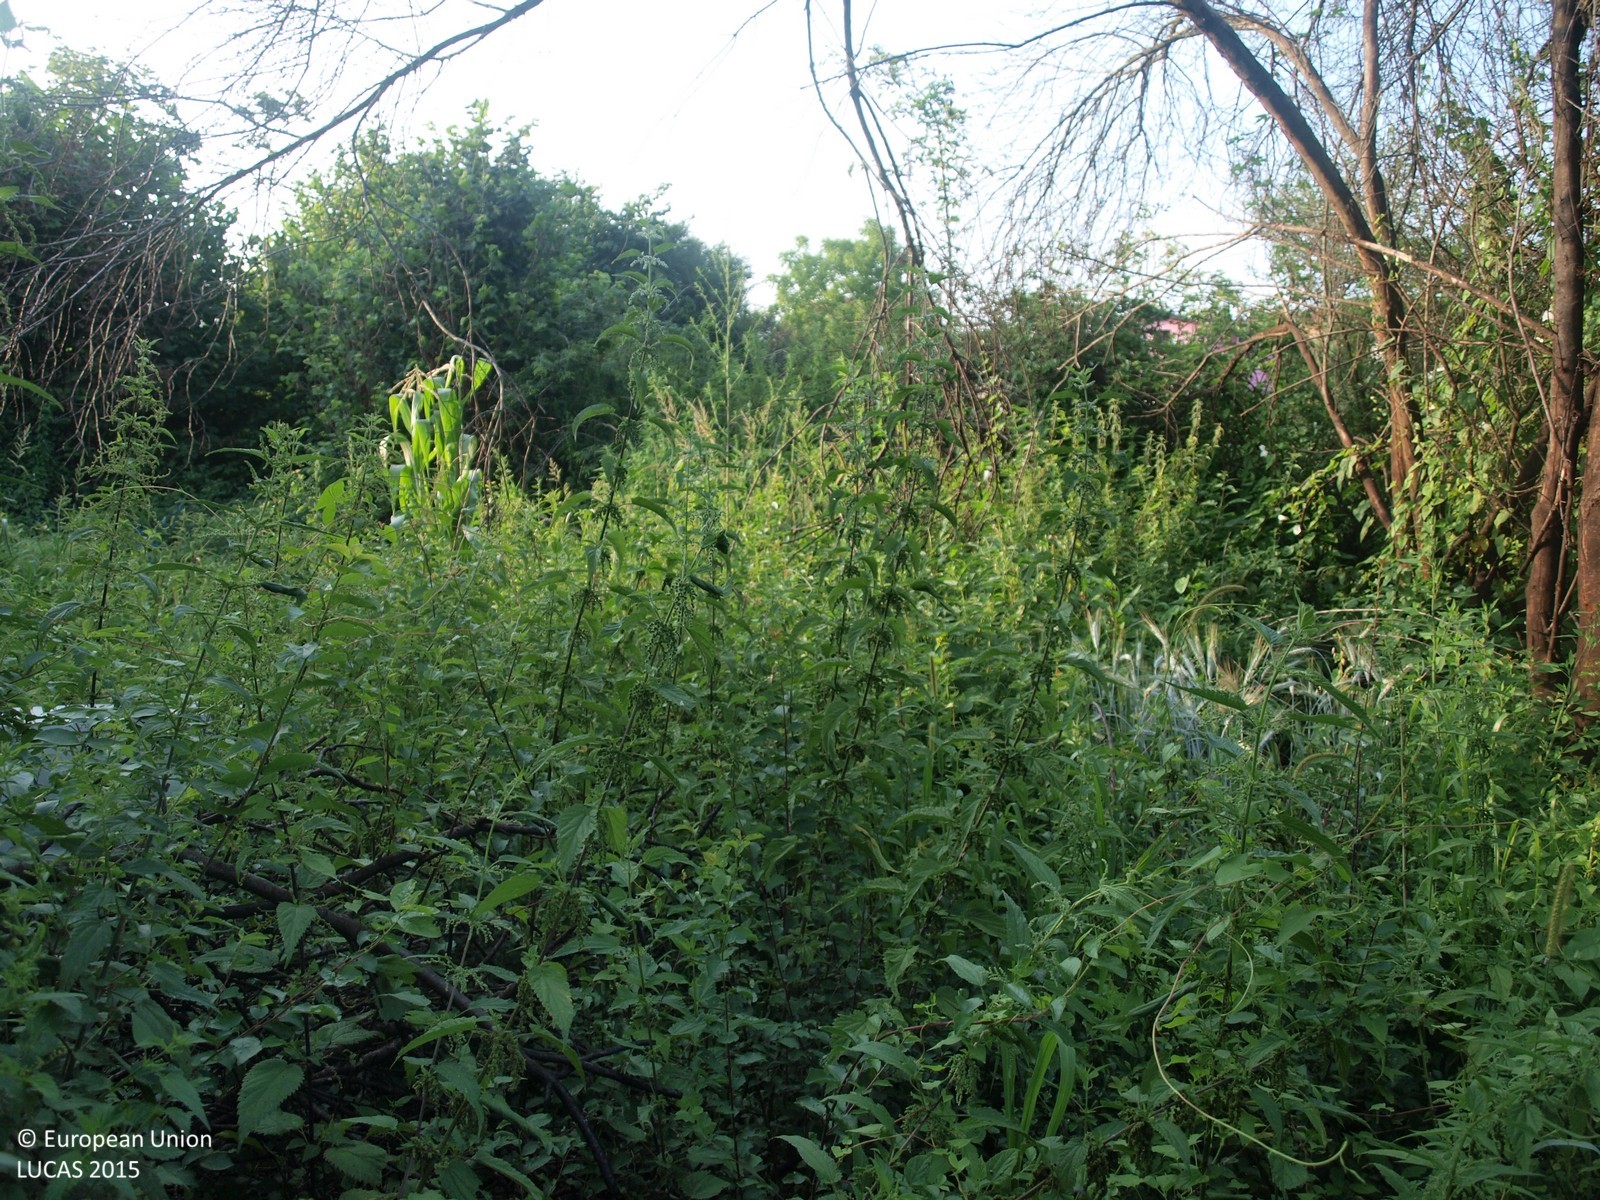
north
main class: Shrubland
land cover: Shrubland with sparse tree cover
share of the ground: > 75 %
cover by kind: shrubs 95 %, broadleaved forest trees 5 %
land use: Semi-natural and natural areas not in use
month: August
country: HR
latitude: 45.9692
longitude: 16.2580
